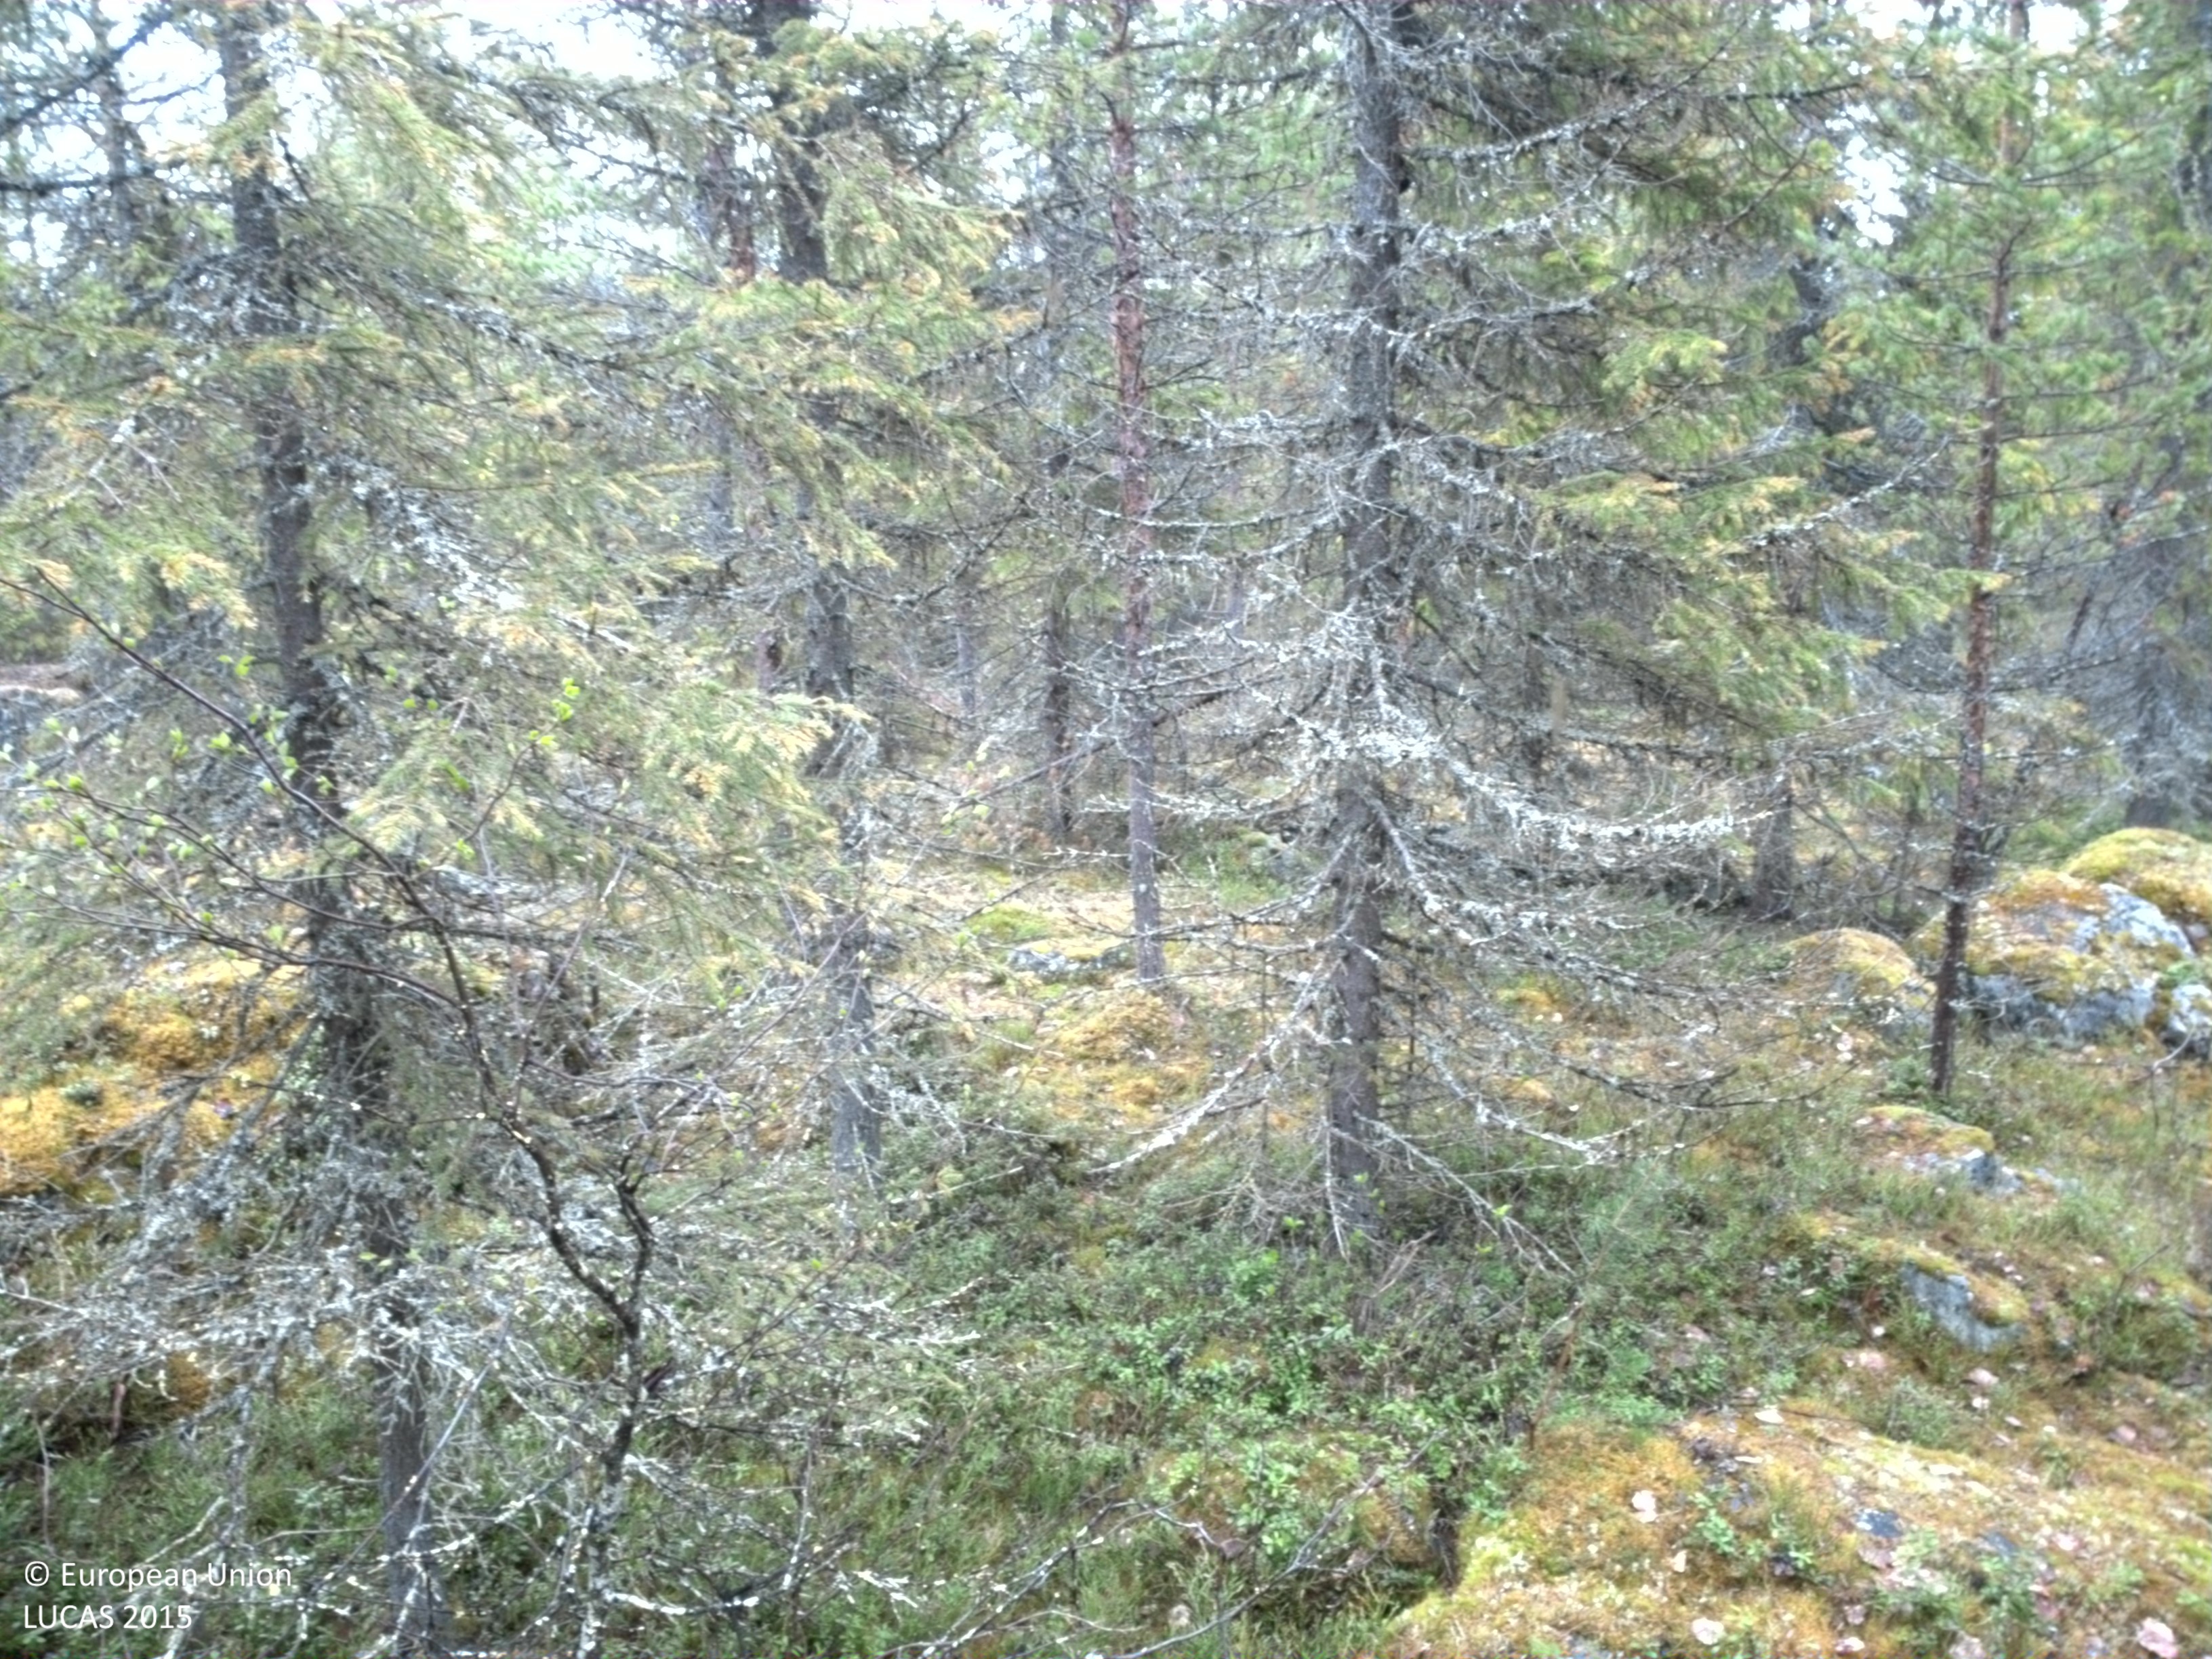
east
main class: Woodland
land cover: Spruce dominated coniferous woodland
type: boreal forest
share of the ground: > 75 %
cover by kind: coniferous forest trees 85 %, shrubs 10 %, lichens and mosses 5 %
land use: Forestry
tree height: > 5 m
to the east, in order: Spruce dominated coniferous woodland
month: May
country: SE
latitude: 66.0913
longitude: 23.1416
